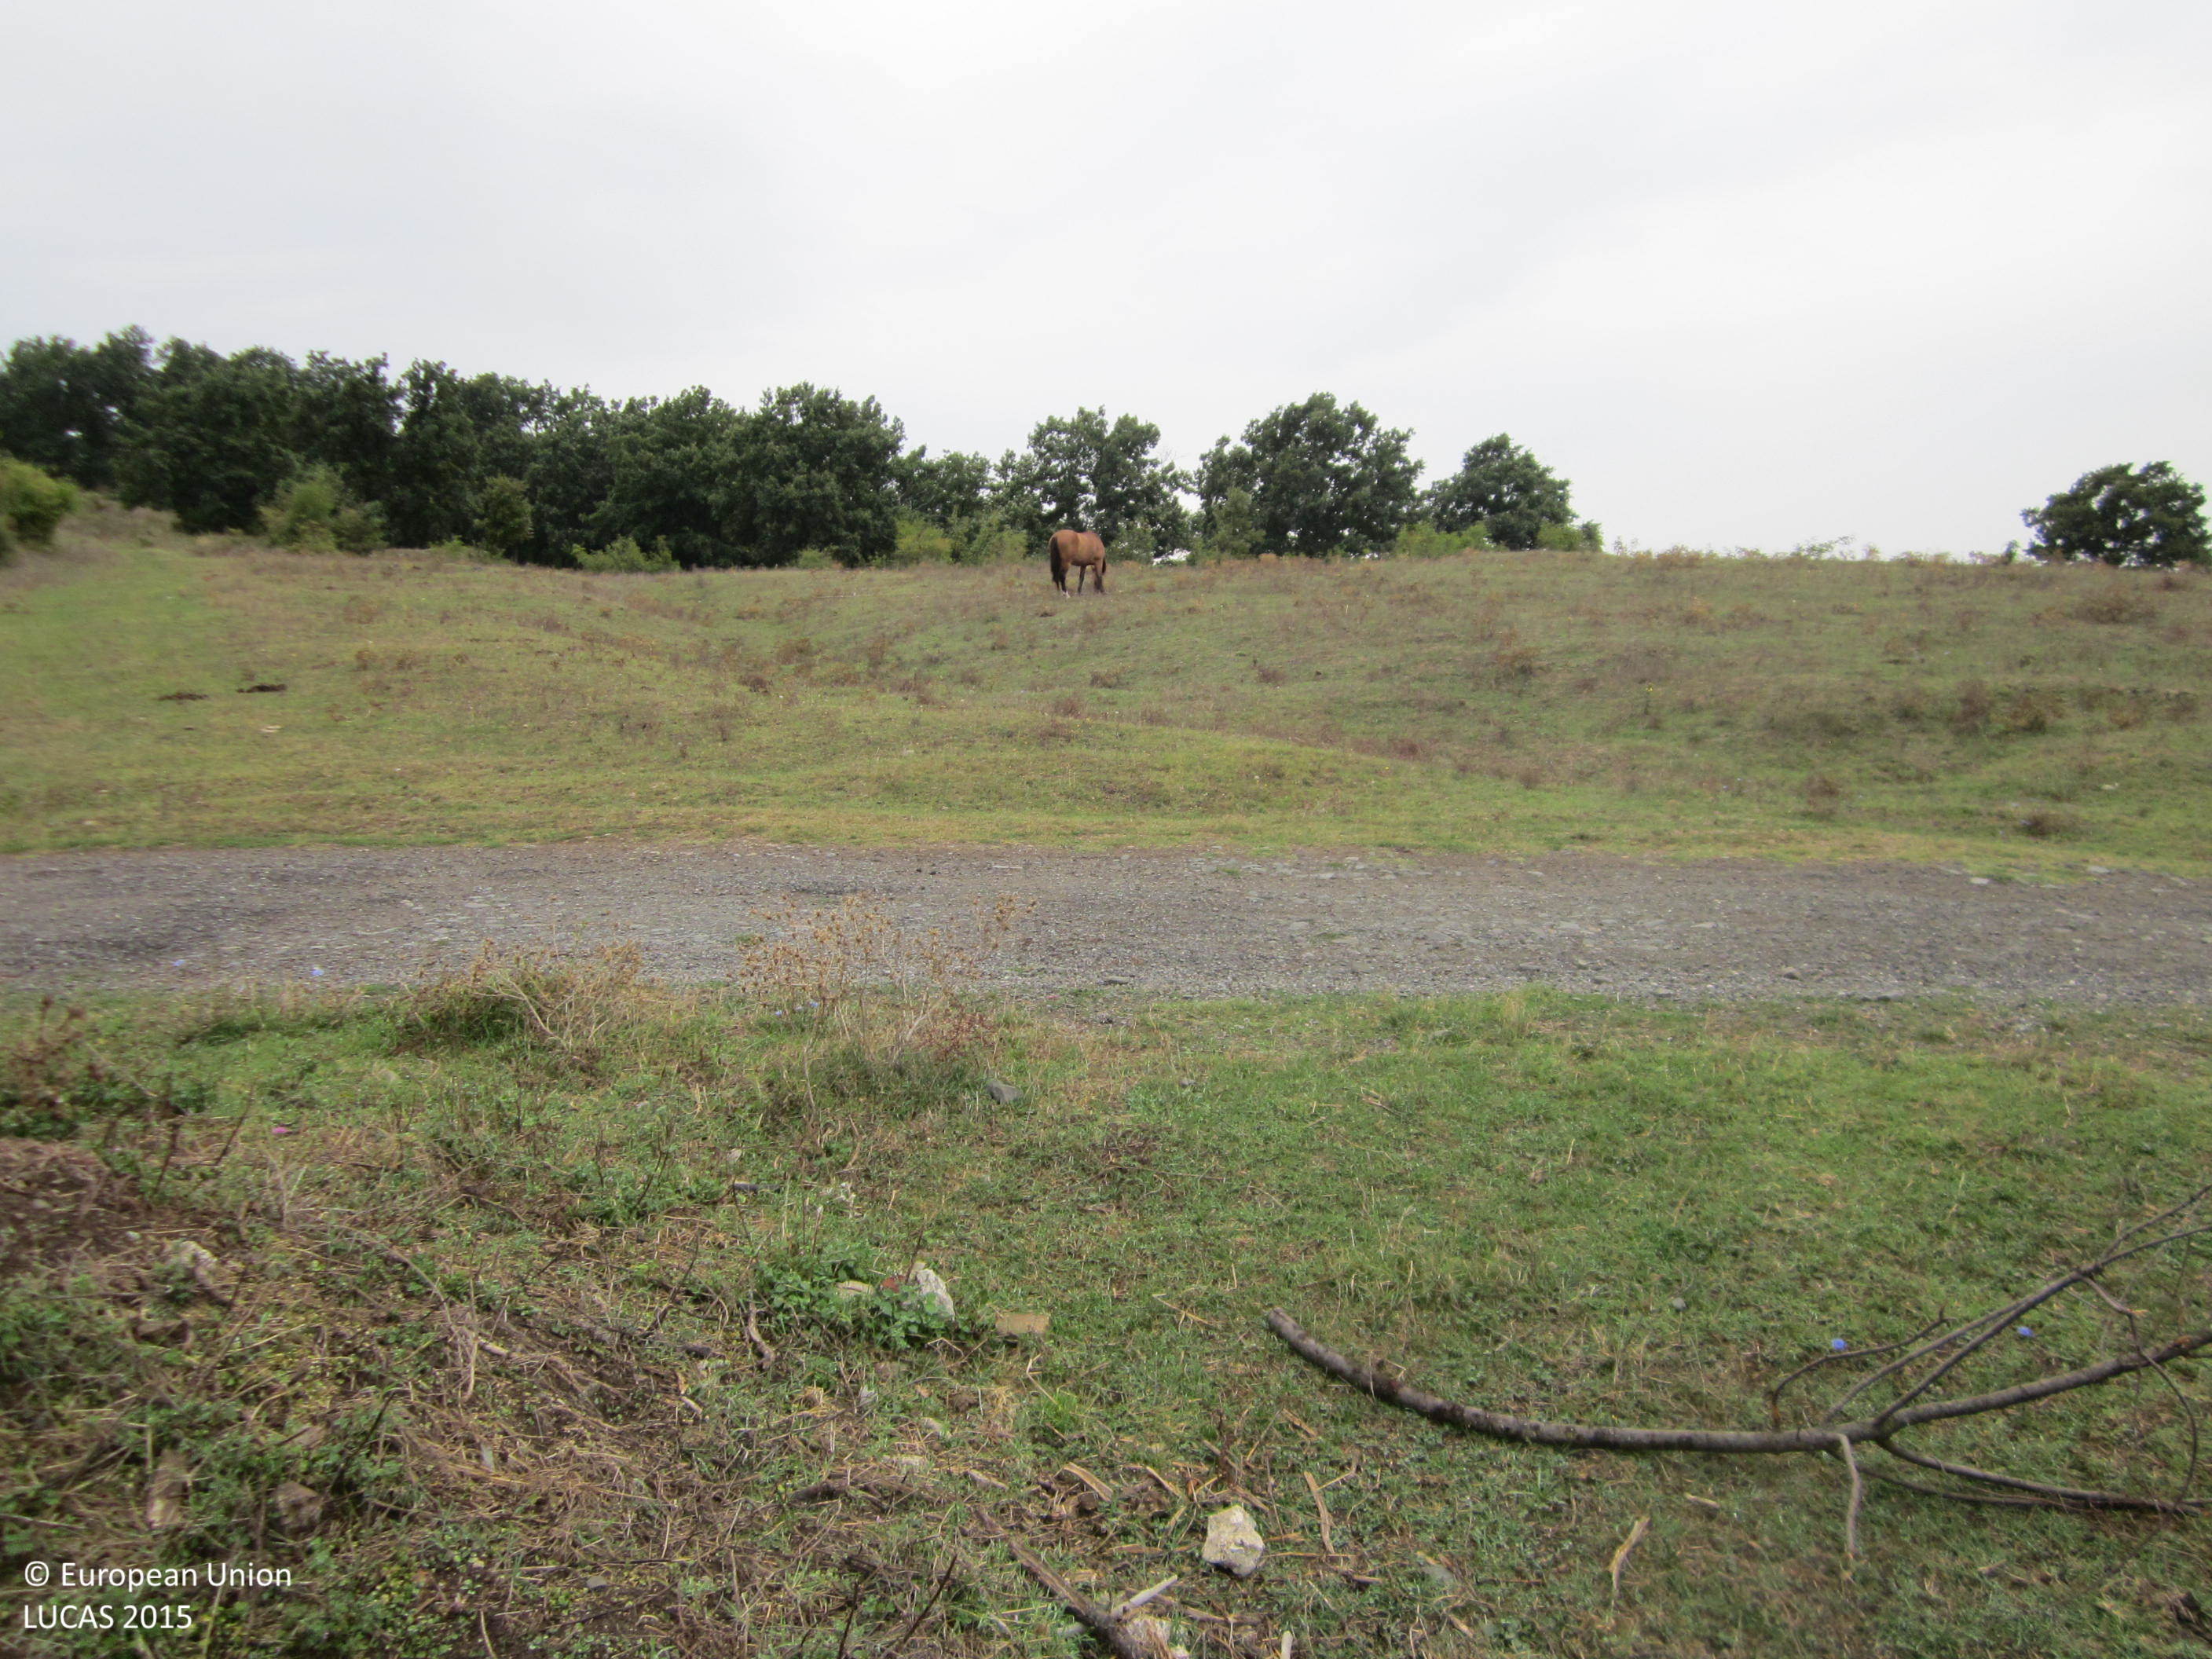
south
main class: Grassland
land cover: Grassland without tree/shrub cover
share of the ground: > 75 %
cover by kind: herbaceous plants 100 %
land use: Agriculture (excluding fallow land and kitchen gardens)
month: September
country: BG
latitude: 42.3384
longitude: 27.2592
